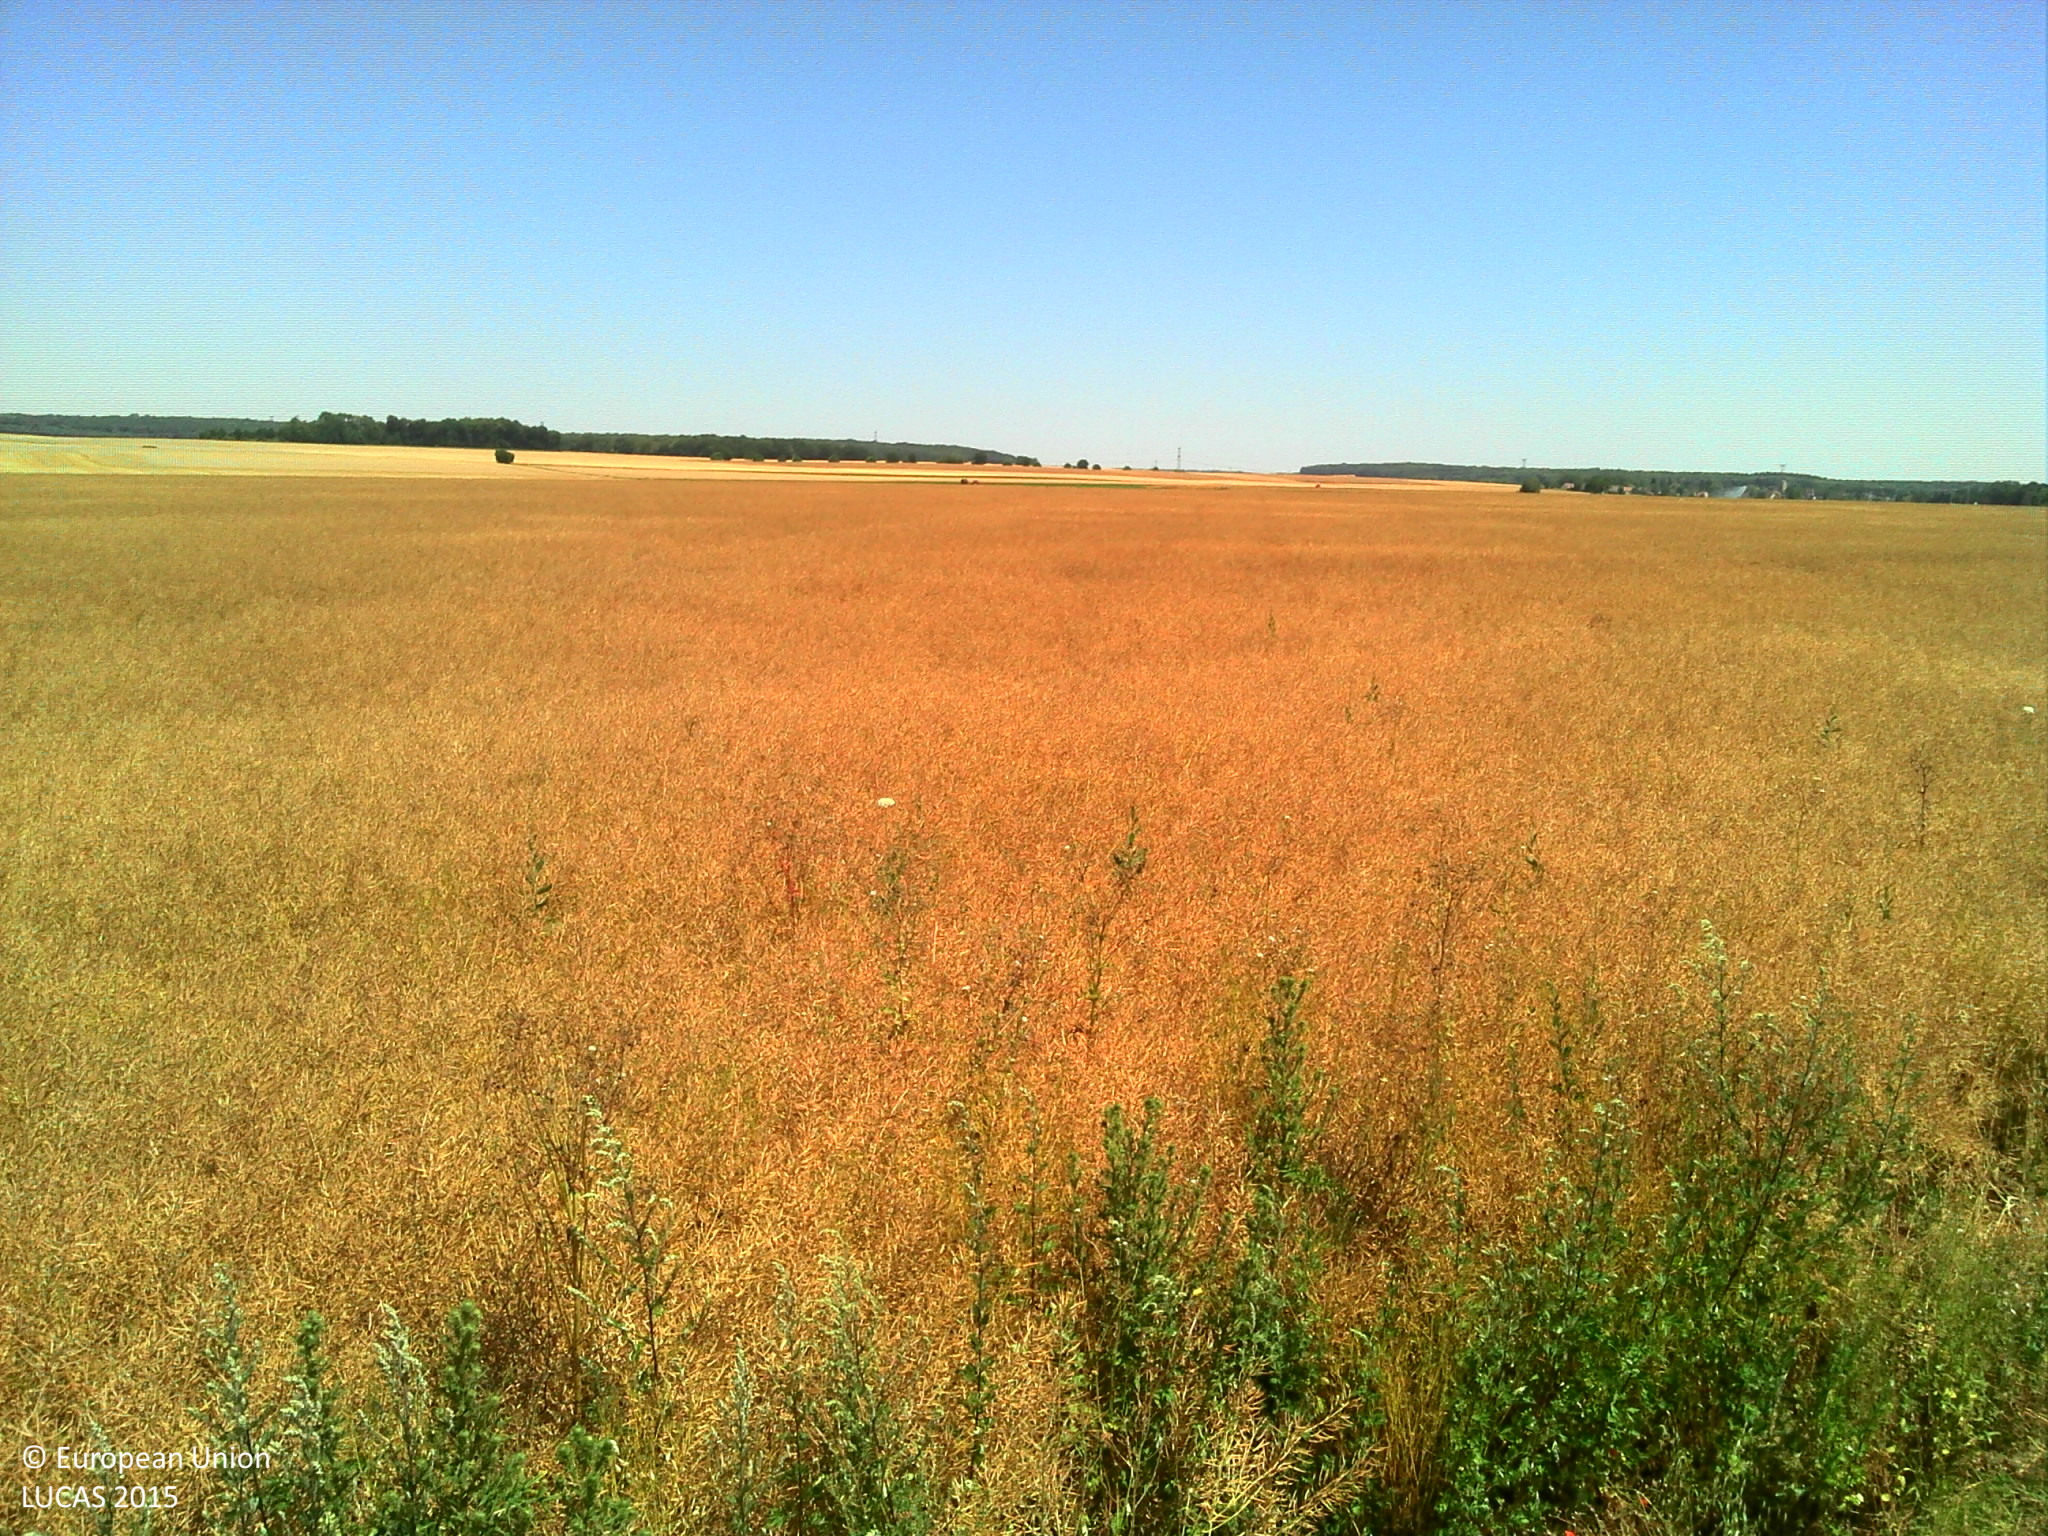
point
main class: Cropland
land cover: Rape and turnip rape
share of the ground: > 75 %
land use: Agriculture (excluding fallow land and kitchen gardens)
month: July
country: FR
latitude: 49.2485
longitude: 1.9485
